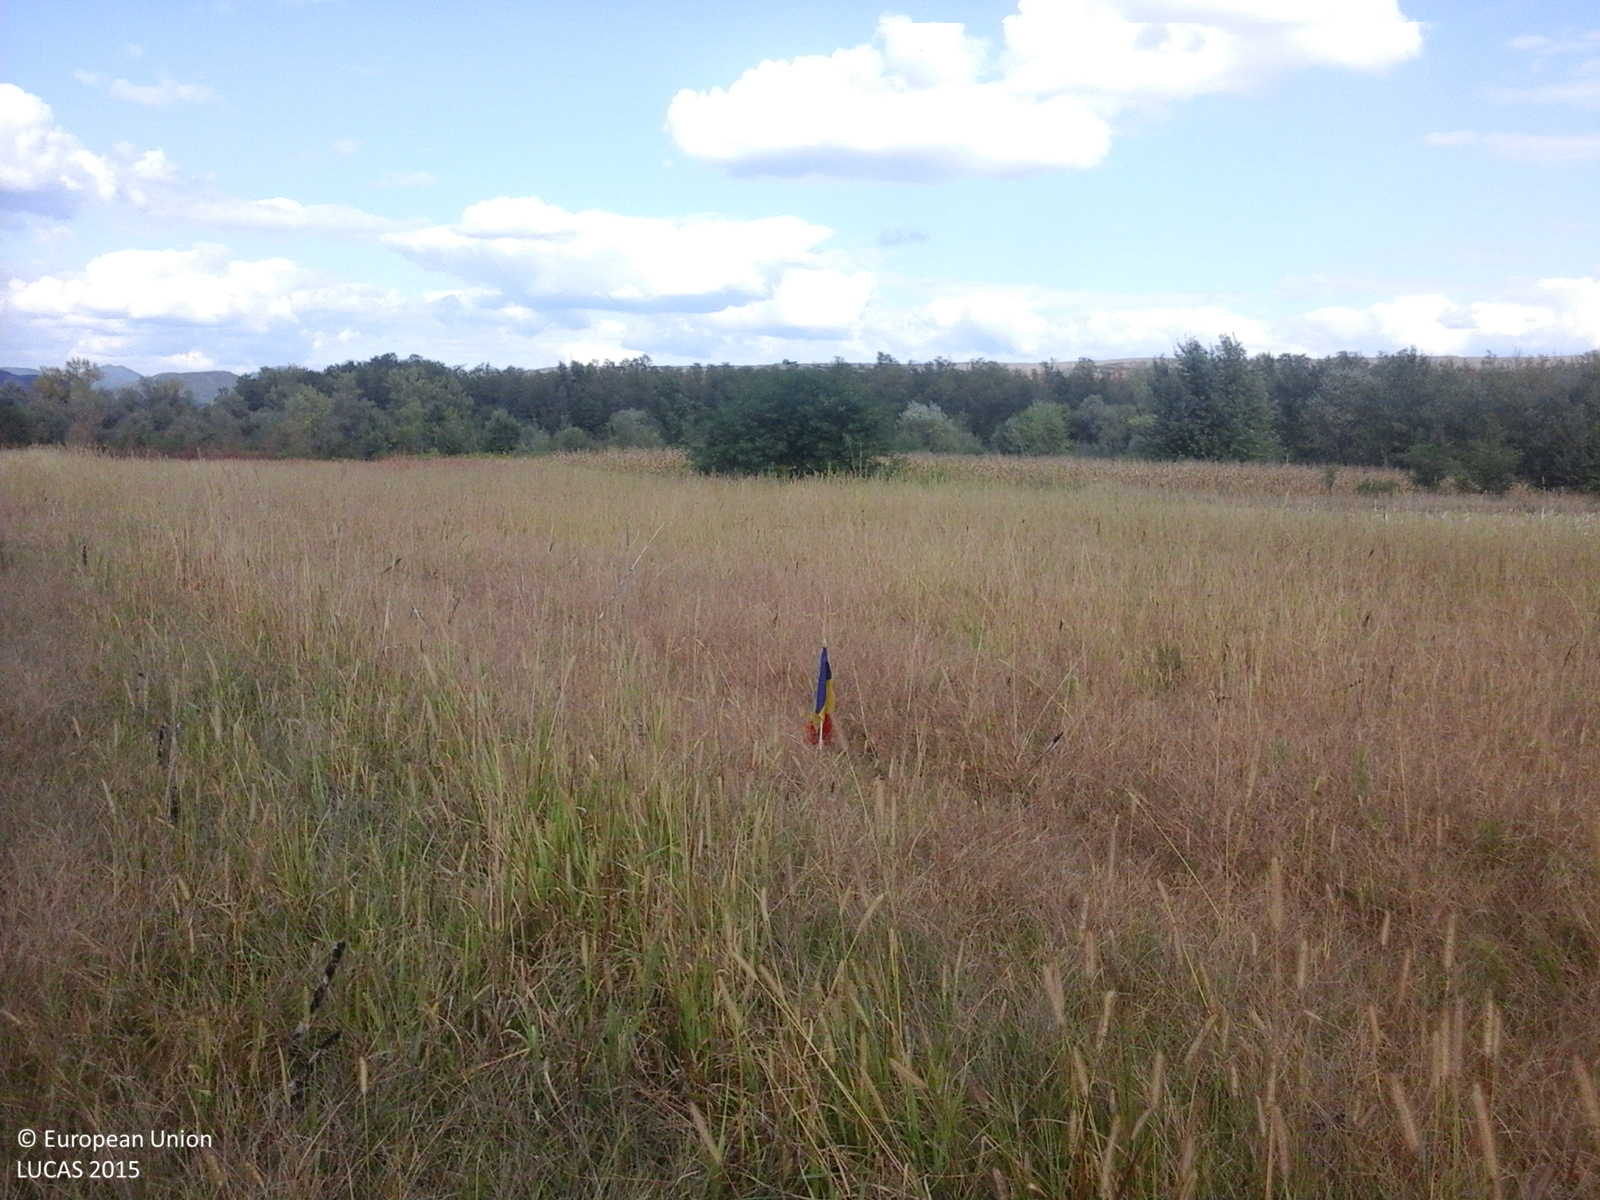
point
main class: Grassland
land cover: Spontaneously vegetated surfaces
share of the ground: > 75 %
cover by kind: herbaceous plants 100 %
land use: Fallow land
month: September
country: RO
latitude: 47.6320
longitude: 23.4487
